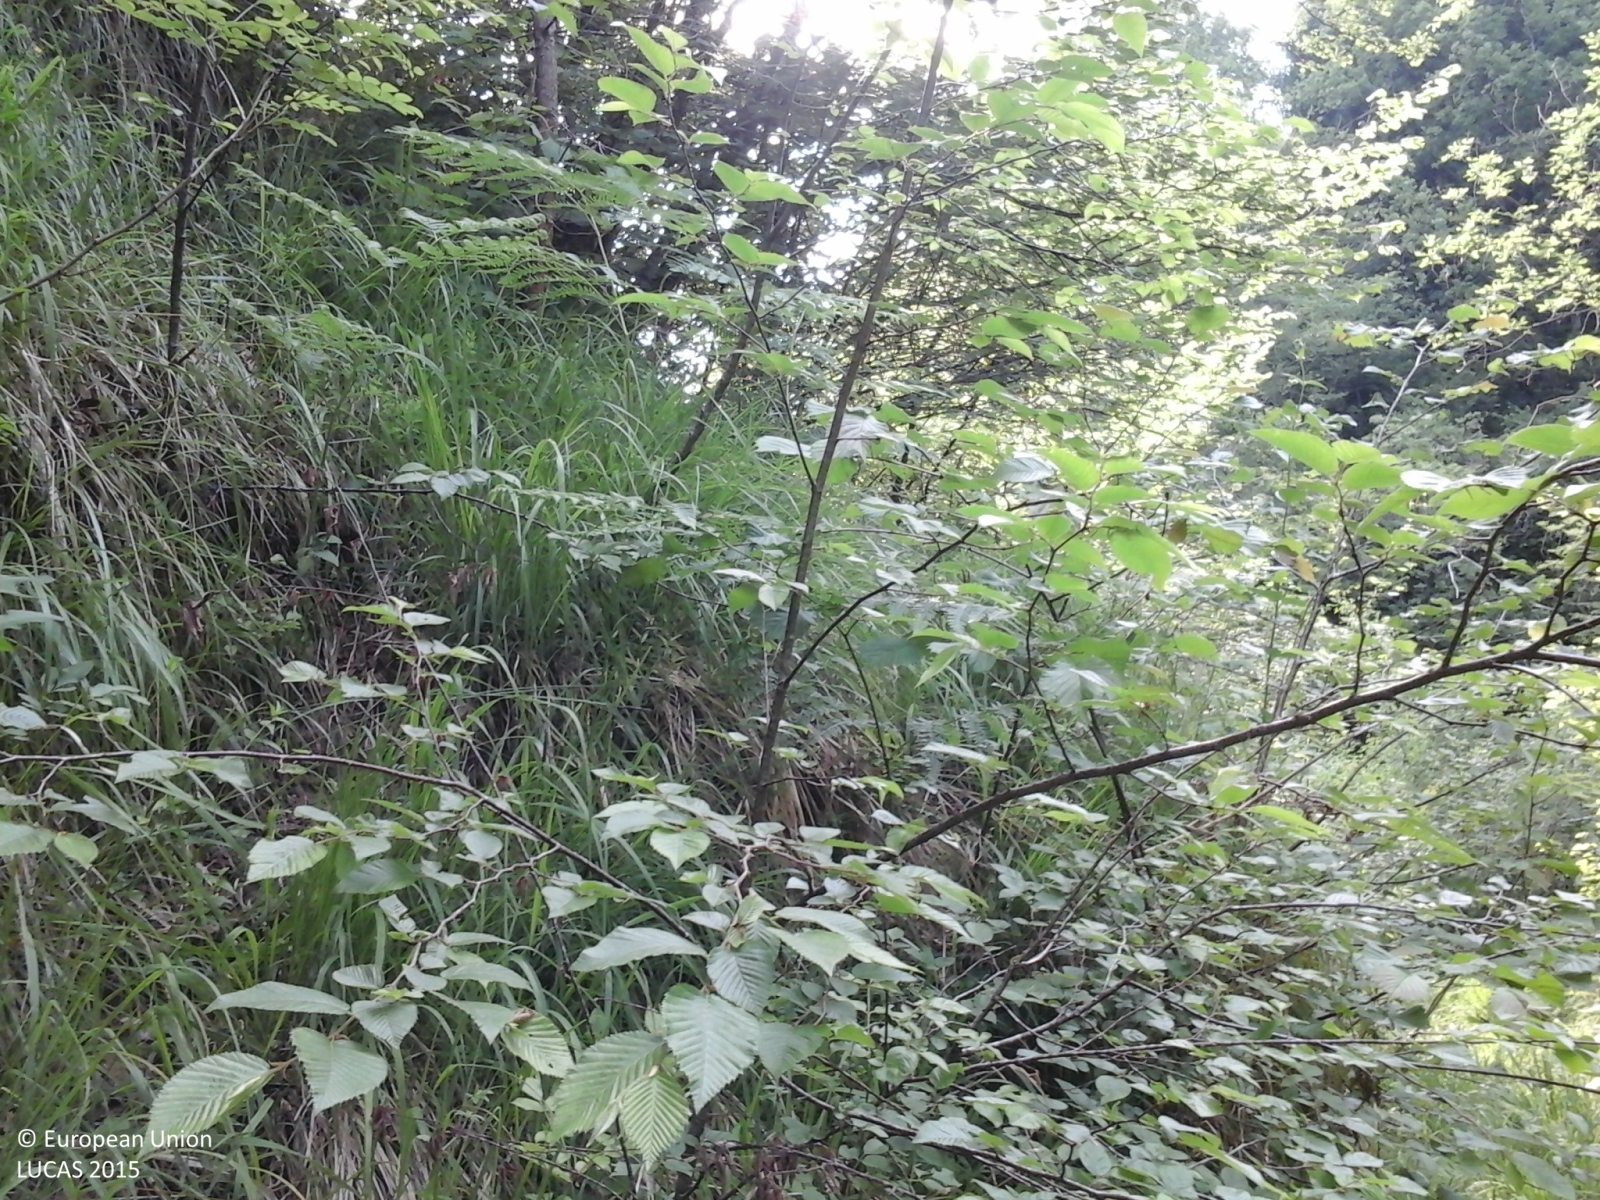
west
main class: Woodland
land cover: Other mixed woodland
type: mesophytic deciduous forest
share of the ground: > 75 %
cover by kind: broadleaved forest trees 75 %, coniferous forest trees 25 %
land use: Semi-natural and natural areas not in use
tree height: > 5 m
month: June
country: IT
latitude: 46.0936
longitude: 12.2348
